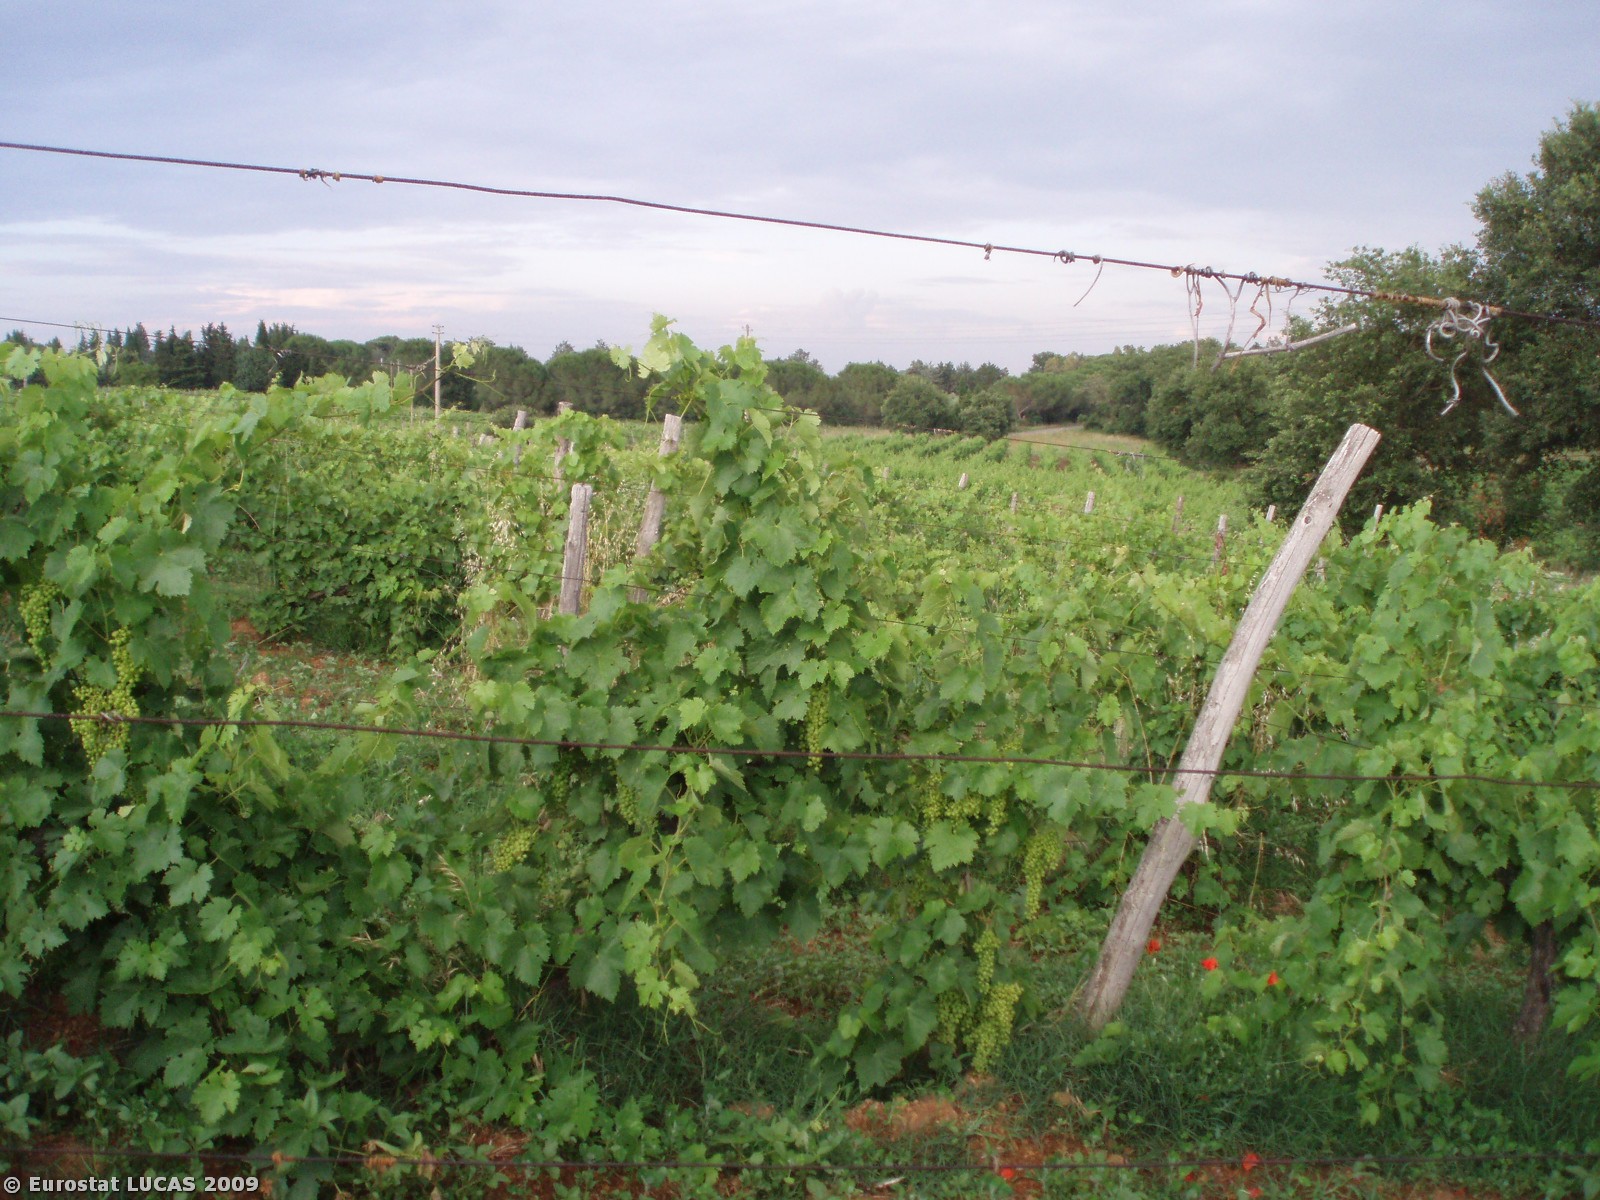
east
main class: Cropland
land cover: Vineyards
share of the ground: 50 - 75 %
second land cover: Spontaneously vegetated surfaces
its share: 50 - 75 %
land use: Agriculture (excluding fallow land and kitchen gardens)
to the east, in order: Vineyards; Spontaneously vegetated surfaces; Electric lines; Ditches and canals; Paved roads, cycling and walking lanes; Vineyards; Bare land; Grass margins; Vineyards; Bare land; Grass margins; Paved roads, cycling and walking lanes; Grass margins
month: June
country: IT
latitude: 42.6231
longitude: 11.6162
